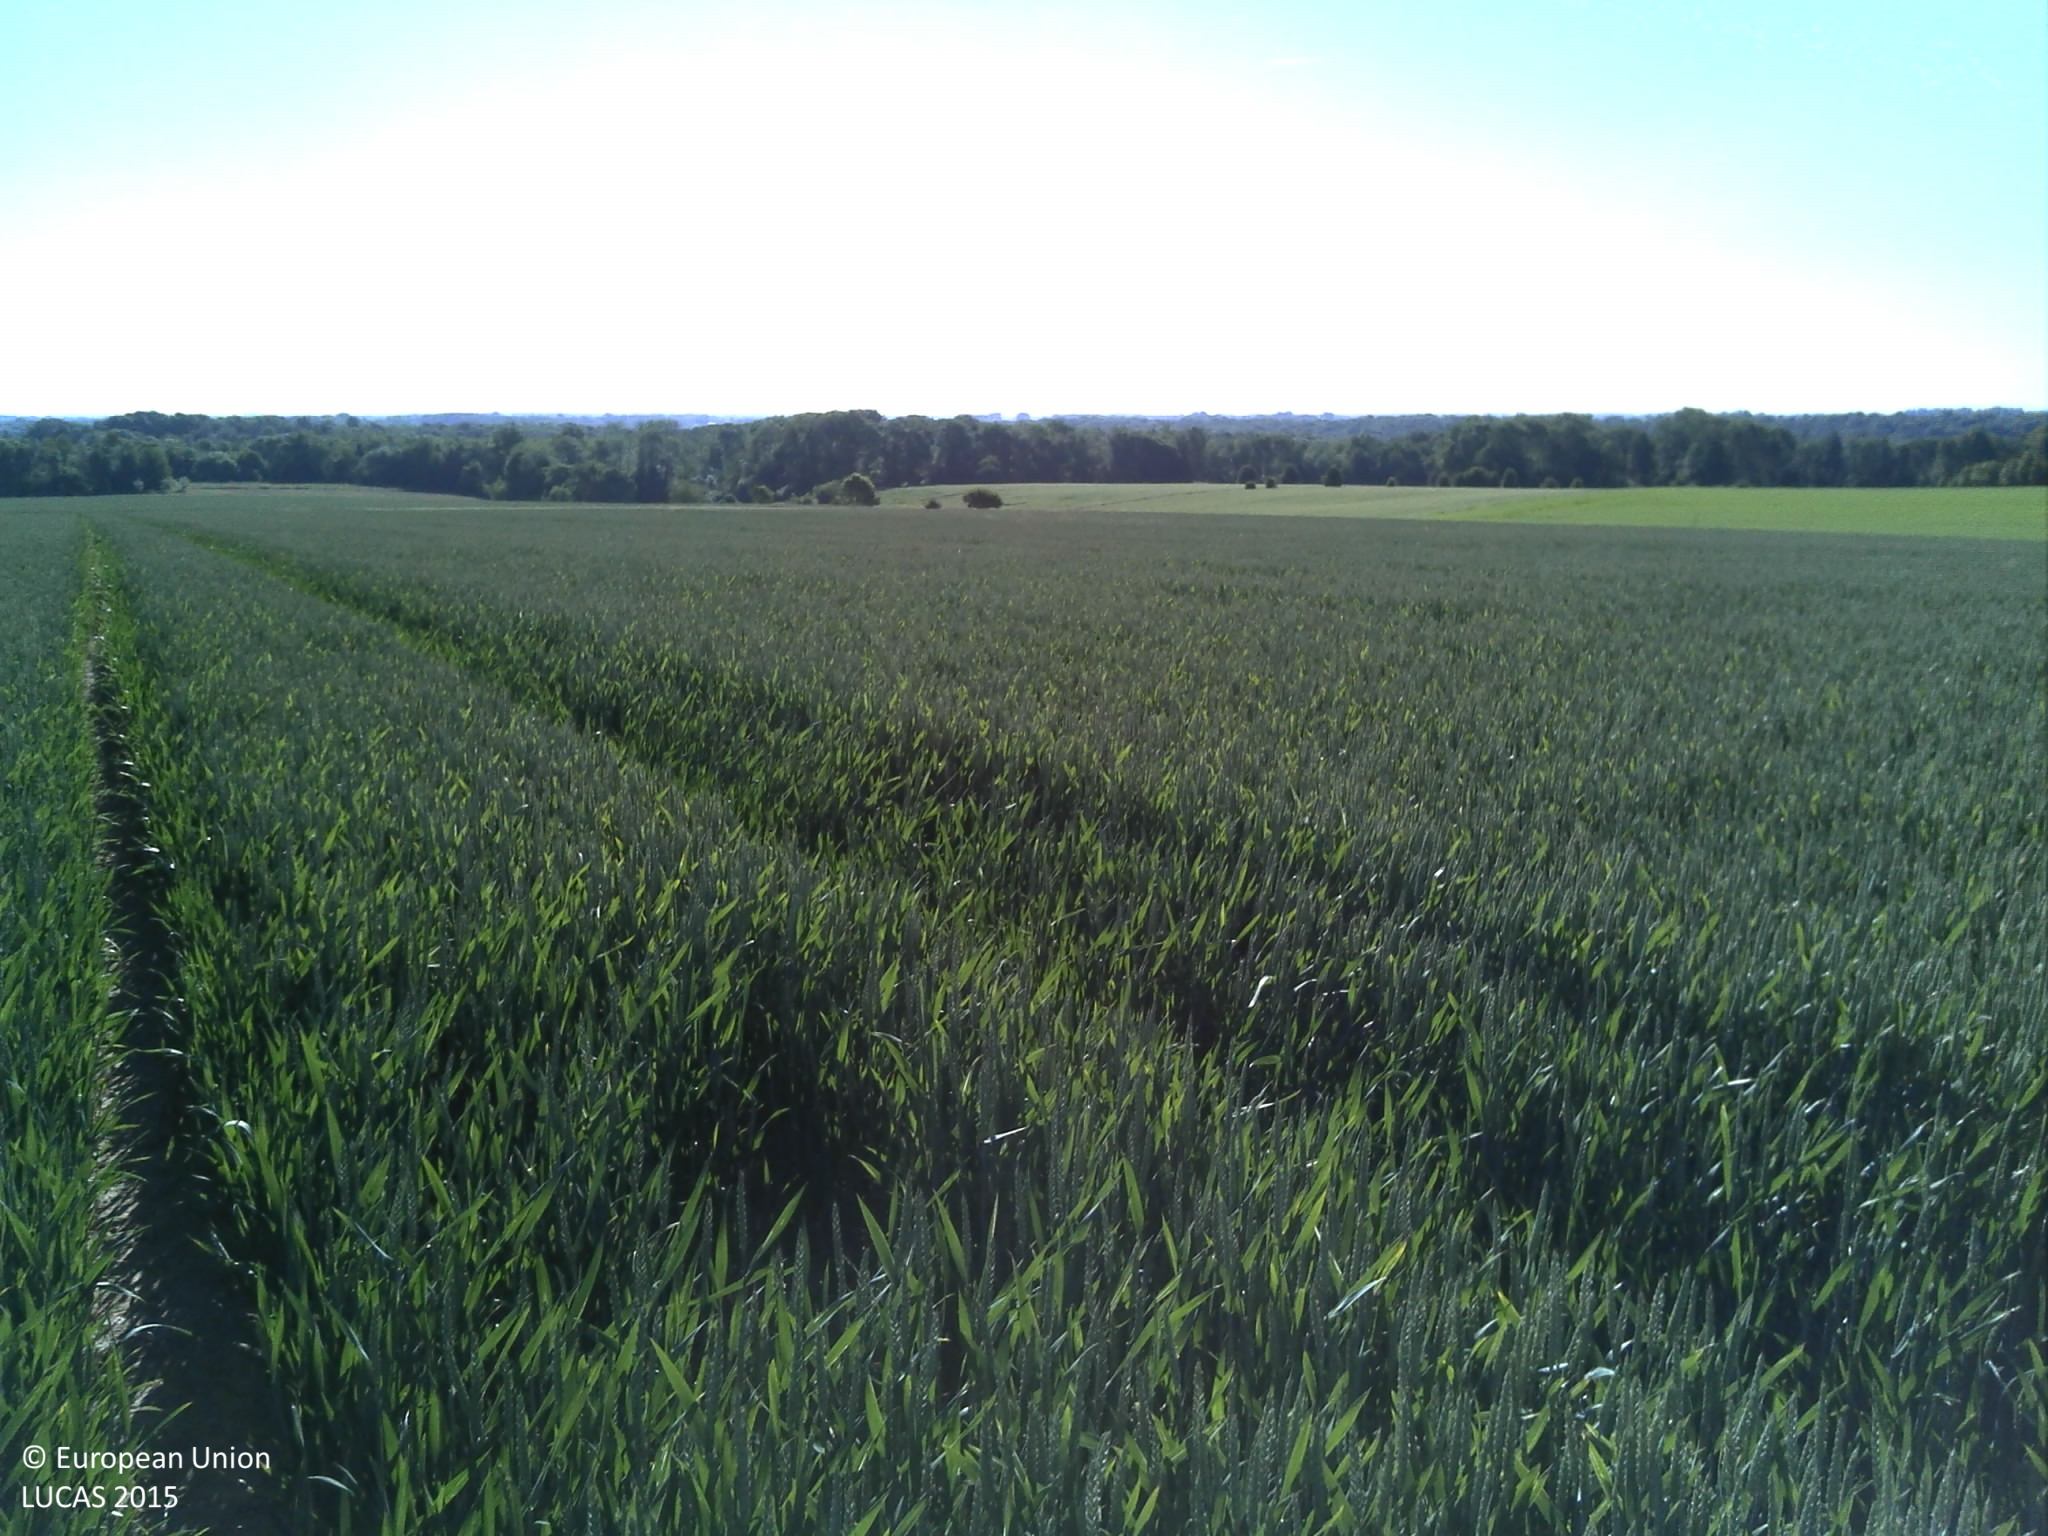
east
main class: Cropland
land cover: Common wheat
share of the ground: > 75 %
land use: Agriculture (excluding fallow land and kitchen gardens)
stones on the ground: < 10 %
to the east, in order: Common wheat
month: June
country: FR
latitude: 49.5990
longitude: 1.0817
